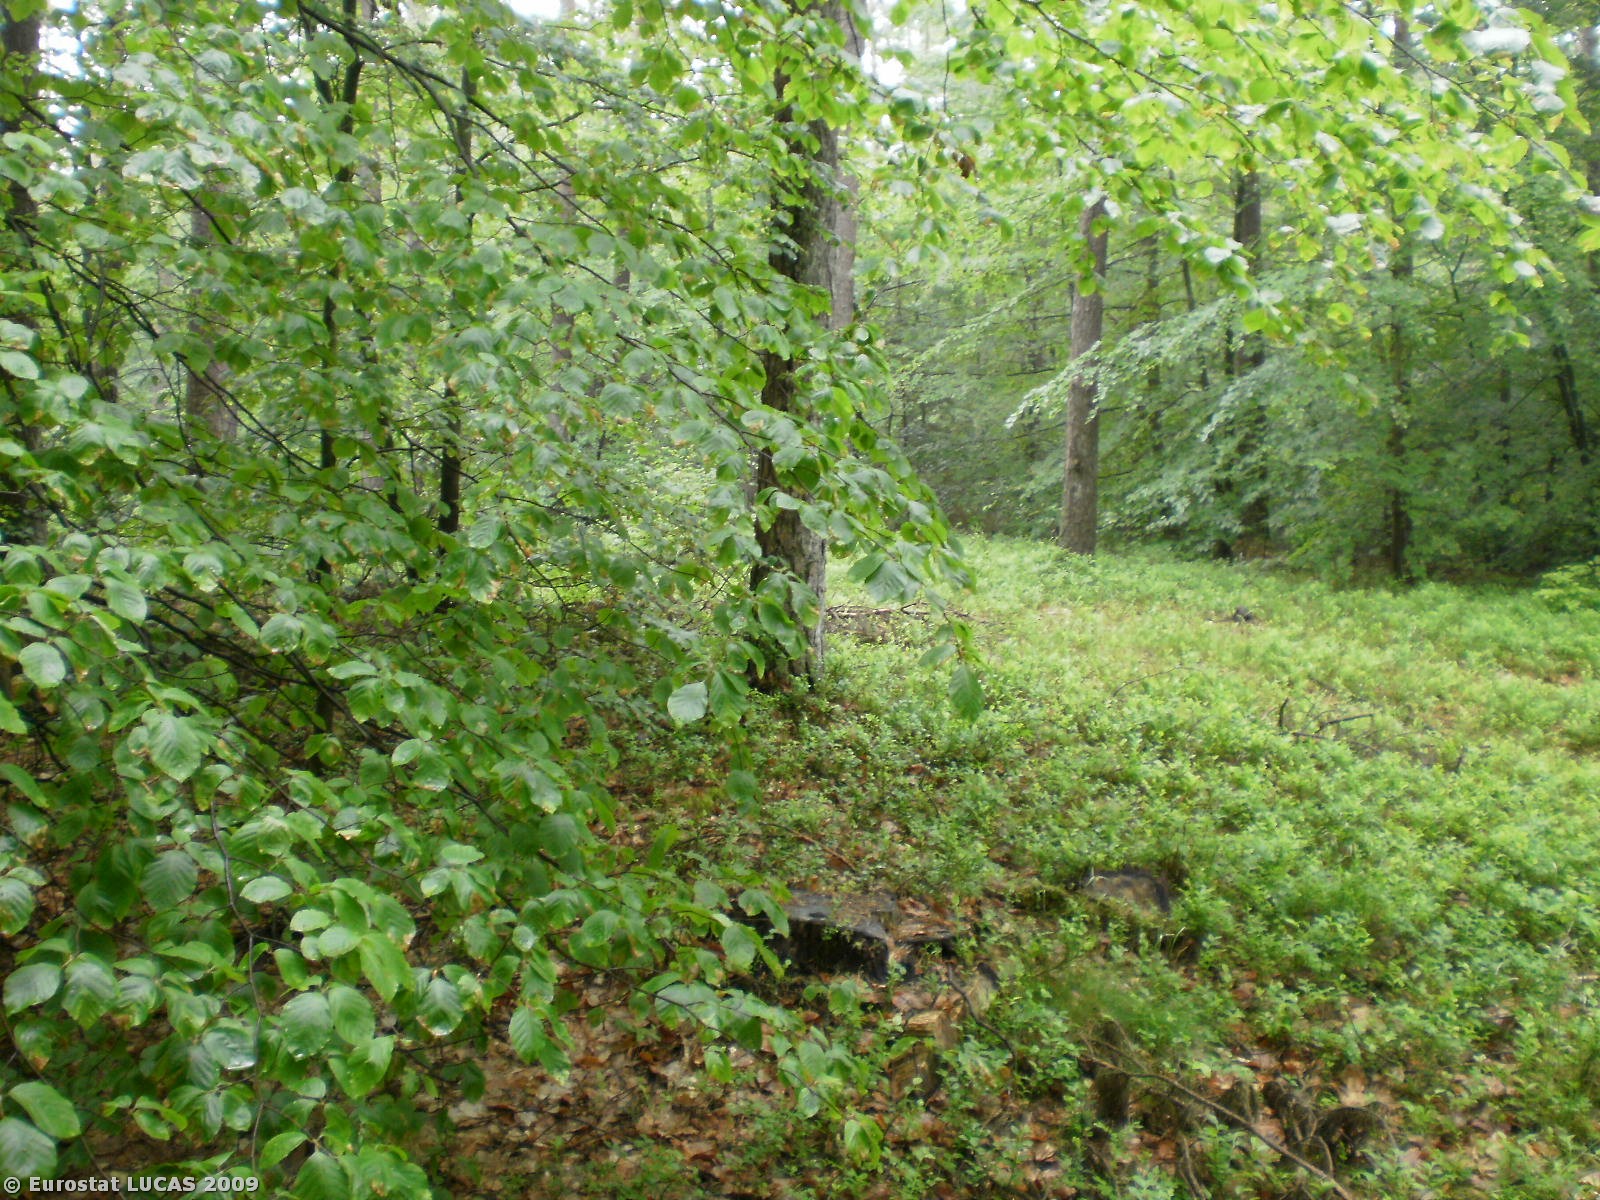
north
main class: Woodland
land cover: Mixed woodland
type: hemiboreal forest and nemoral coniferous forest and mixed broadleaved-coniferous forest
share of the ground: > 75 %
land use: Forestry
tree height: > 5 m
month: June
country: PL
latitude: 54.5539
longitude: 17.8826
